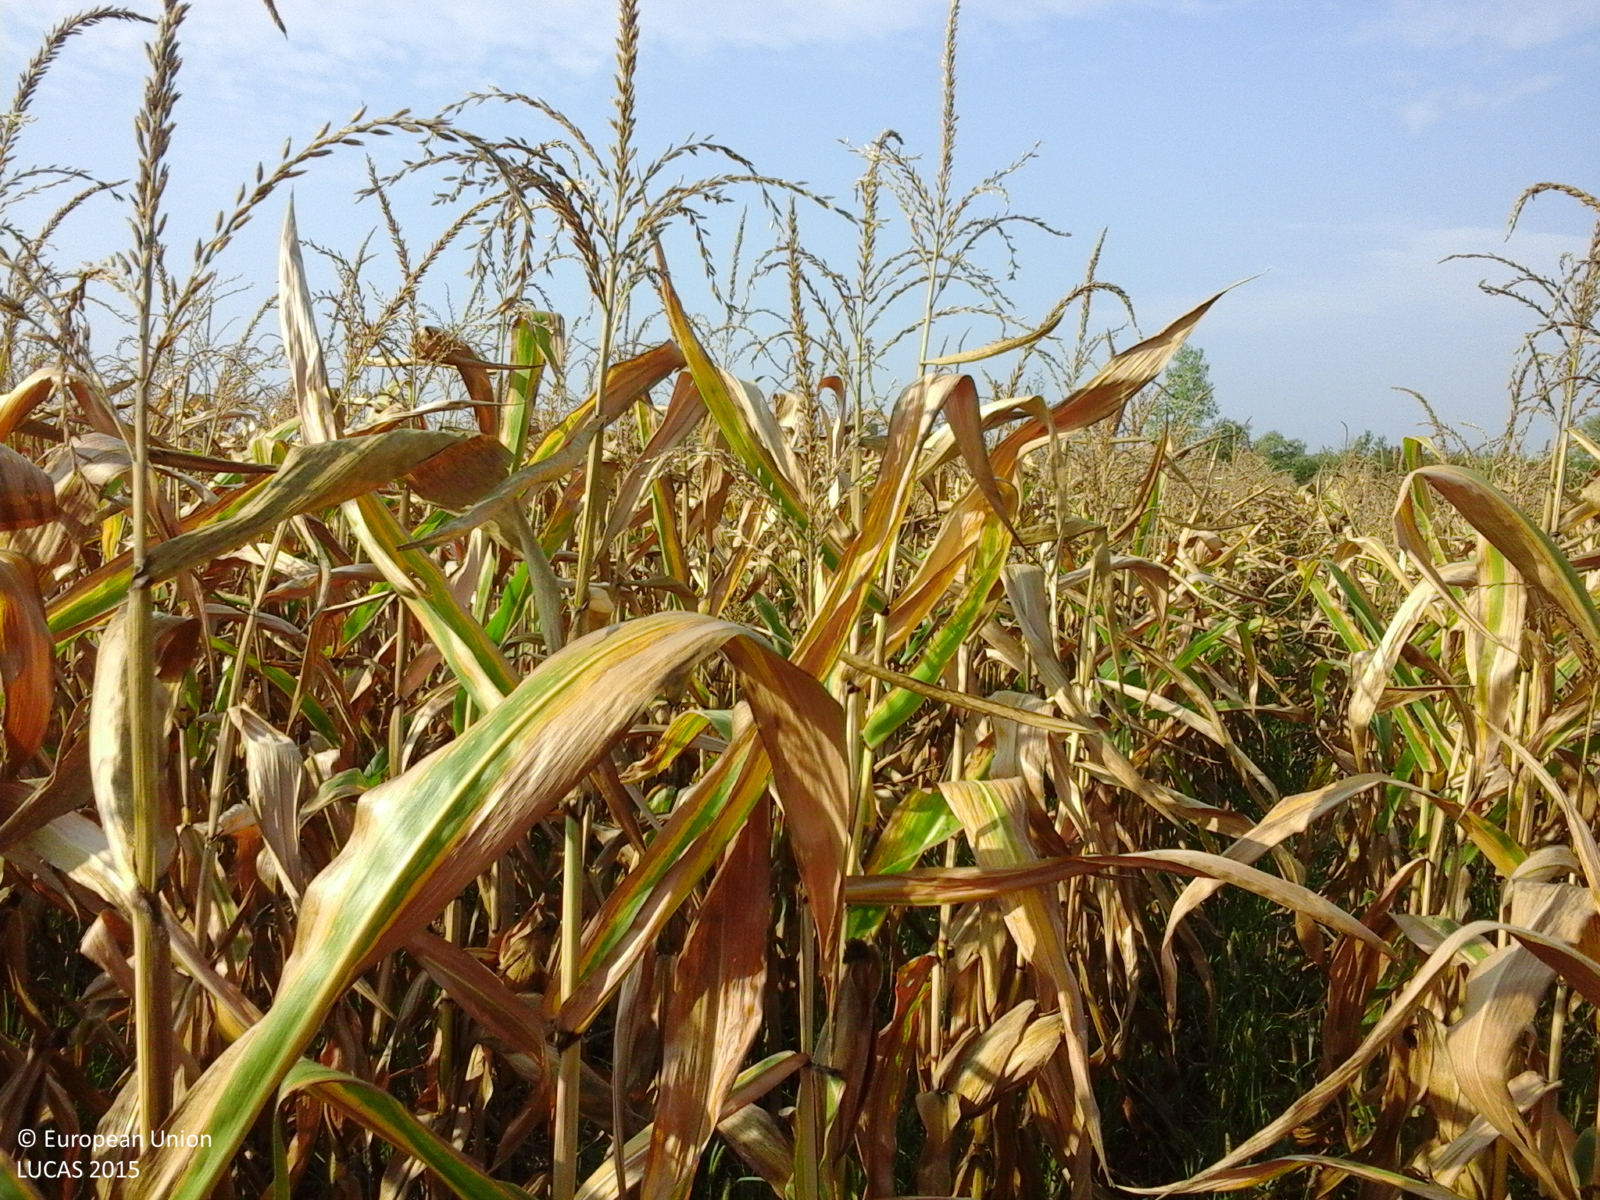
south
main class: Cropland
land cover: Maize
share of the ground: > 75 %
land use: Agriculture (excluding fallow land and kitchen gardens)
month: August
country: RO
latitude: 46.3719
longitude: 22.0957
